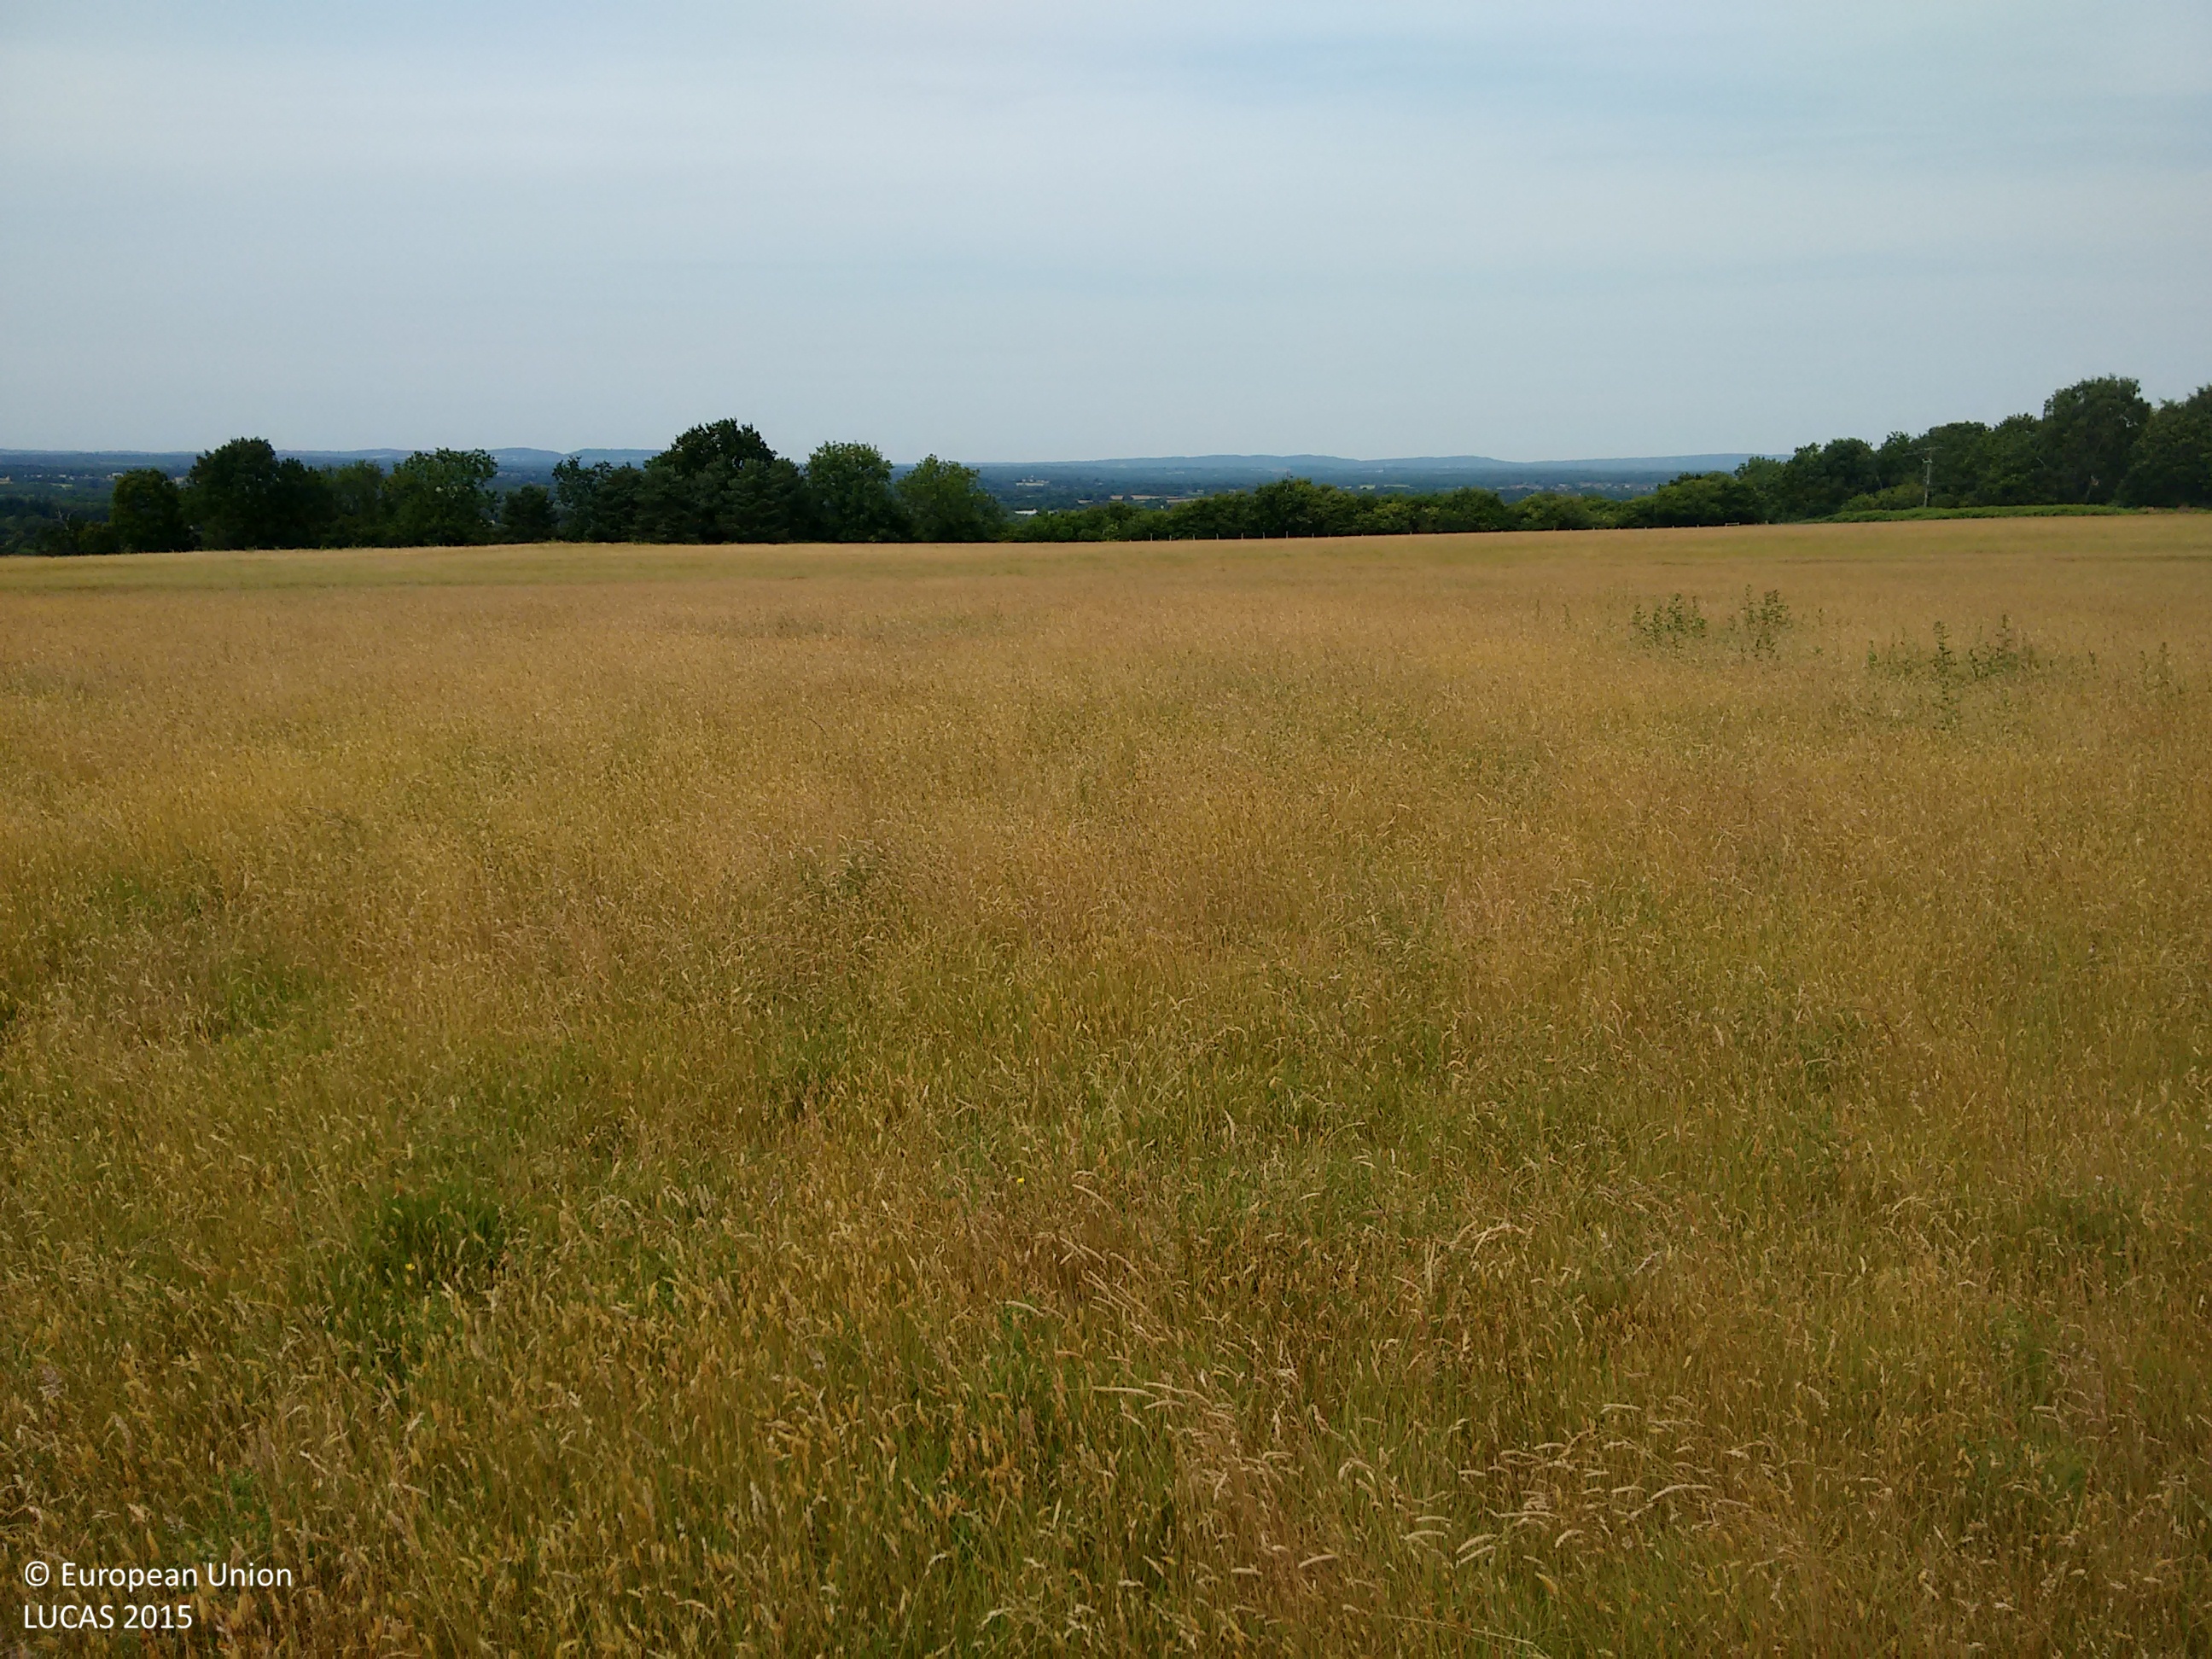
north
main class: Grassland
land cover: Grassland without tree/shrub cover
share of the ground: > 75 %
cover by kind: herbaceous plants 100 %
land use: Agriculture (excluding fallow land and kitchen gardens)
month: July
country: GB
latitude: 50.9697
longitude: -0.4762
